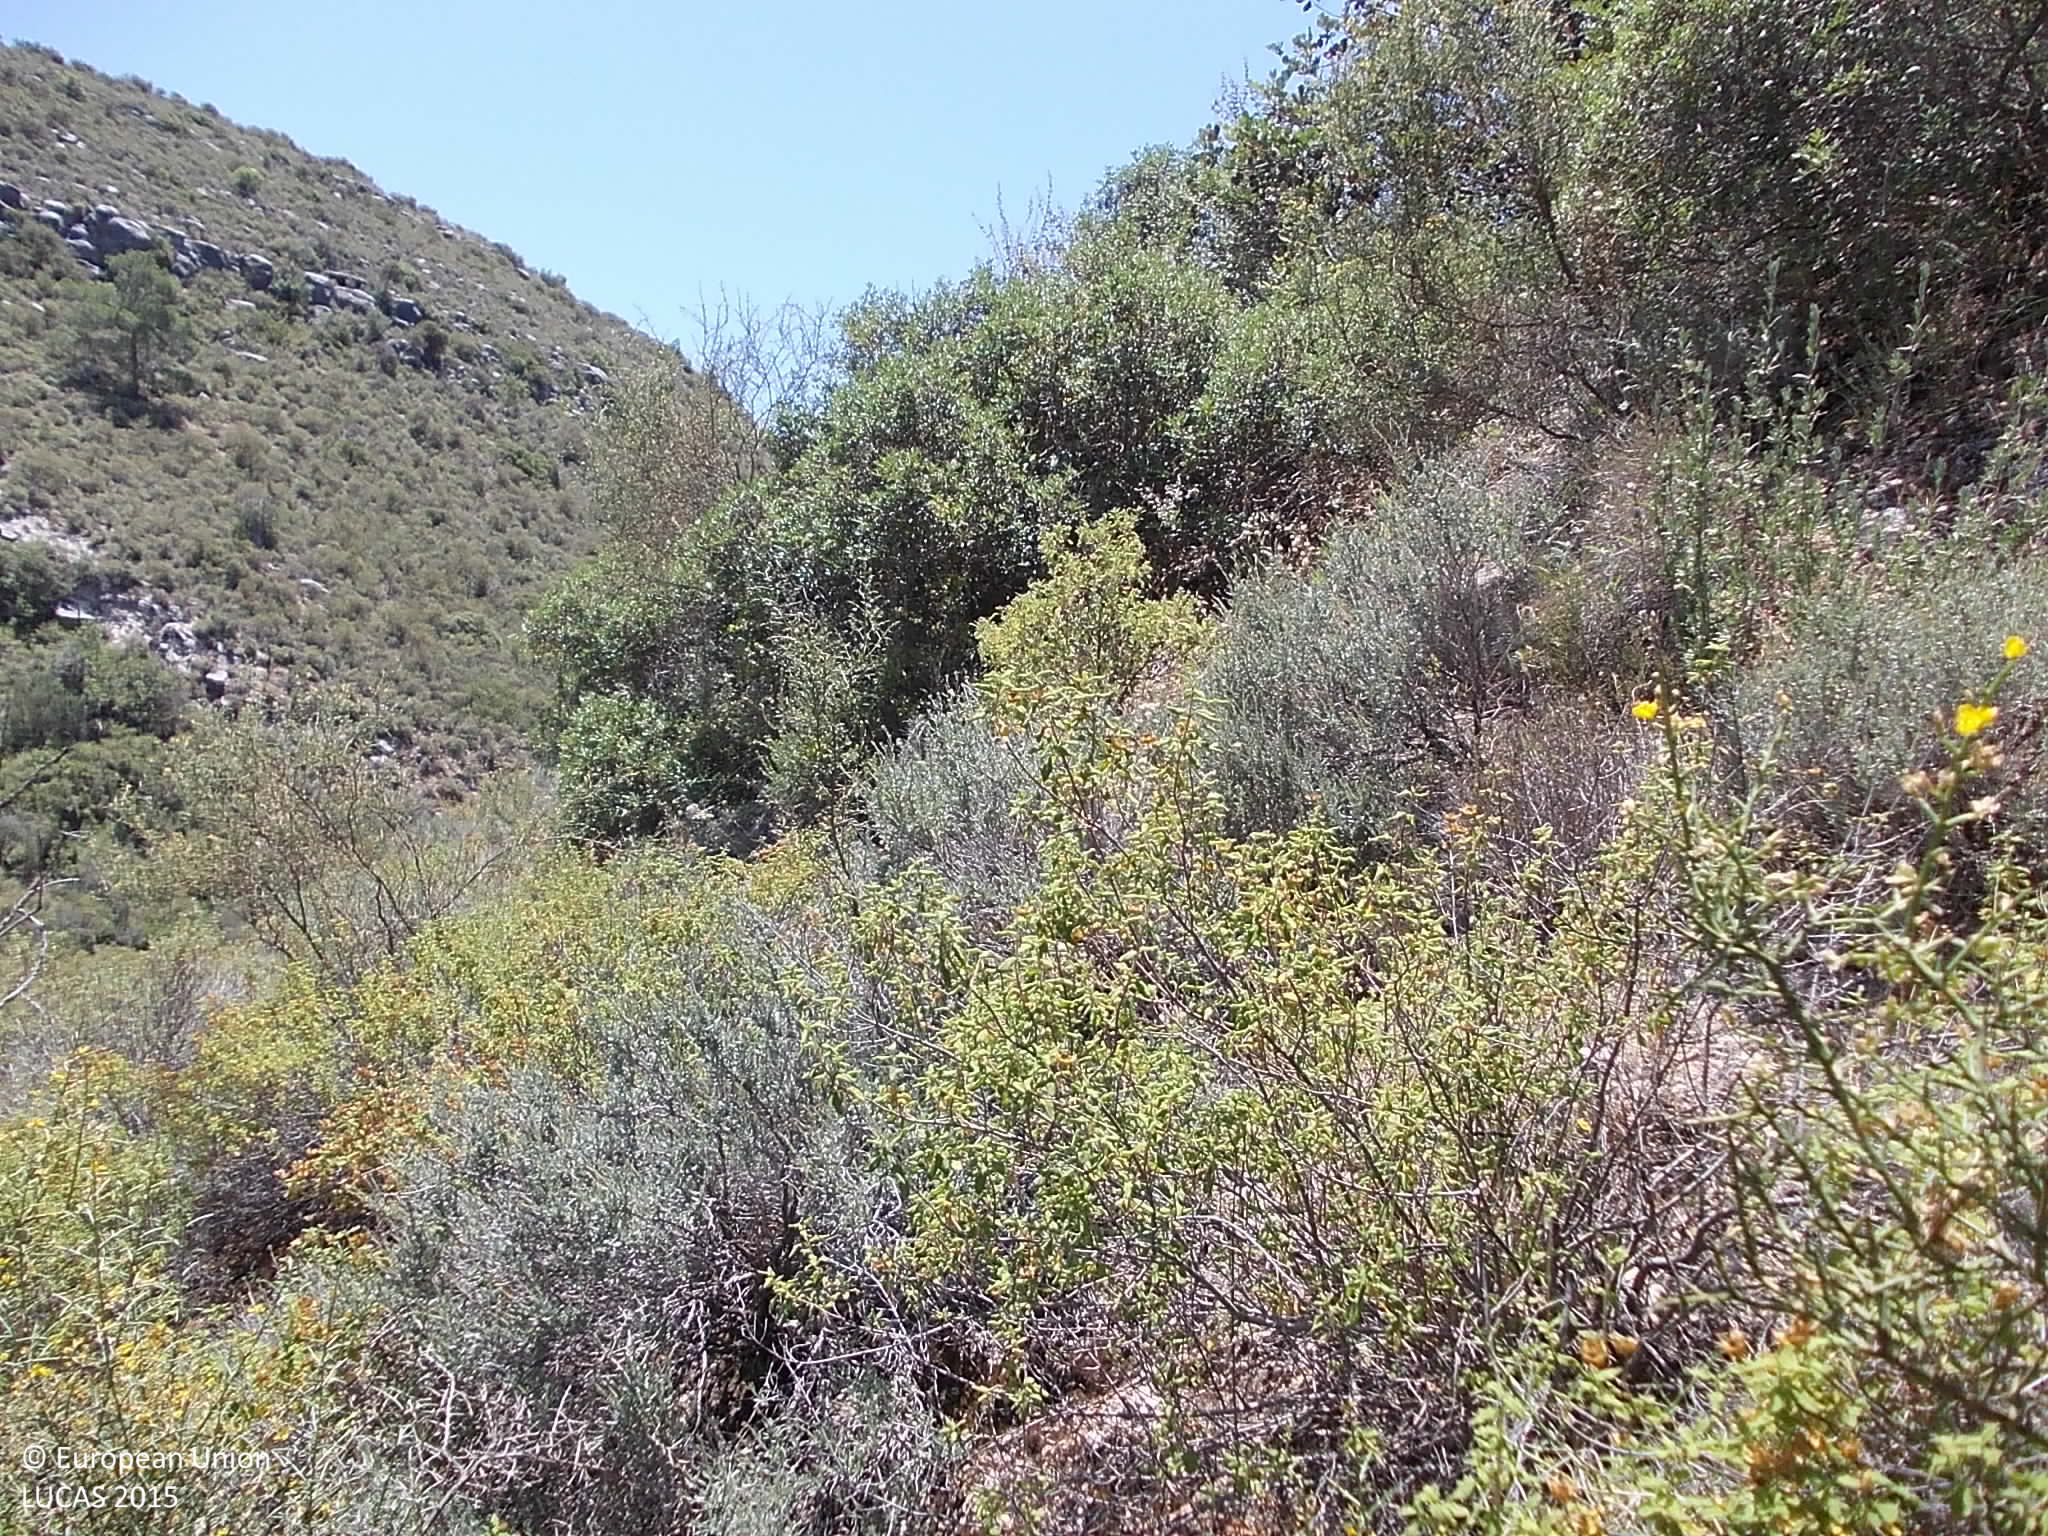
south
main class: Shrubland
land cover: Shrubland without tree cover
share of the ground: > 75 %
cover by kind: shrubs 95 %, unconsolidated bare surface 5 %
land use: Semi-natural and natural areas not in use
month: June
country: CY
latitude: 34.7238
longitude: 32.9078
